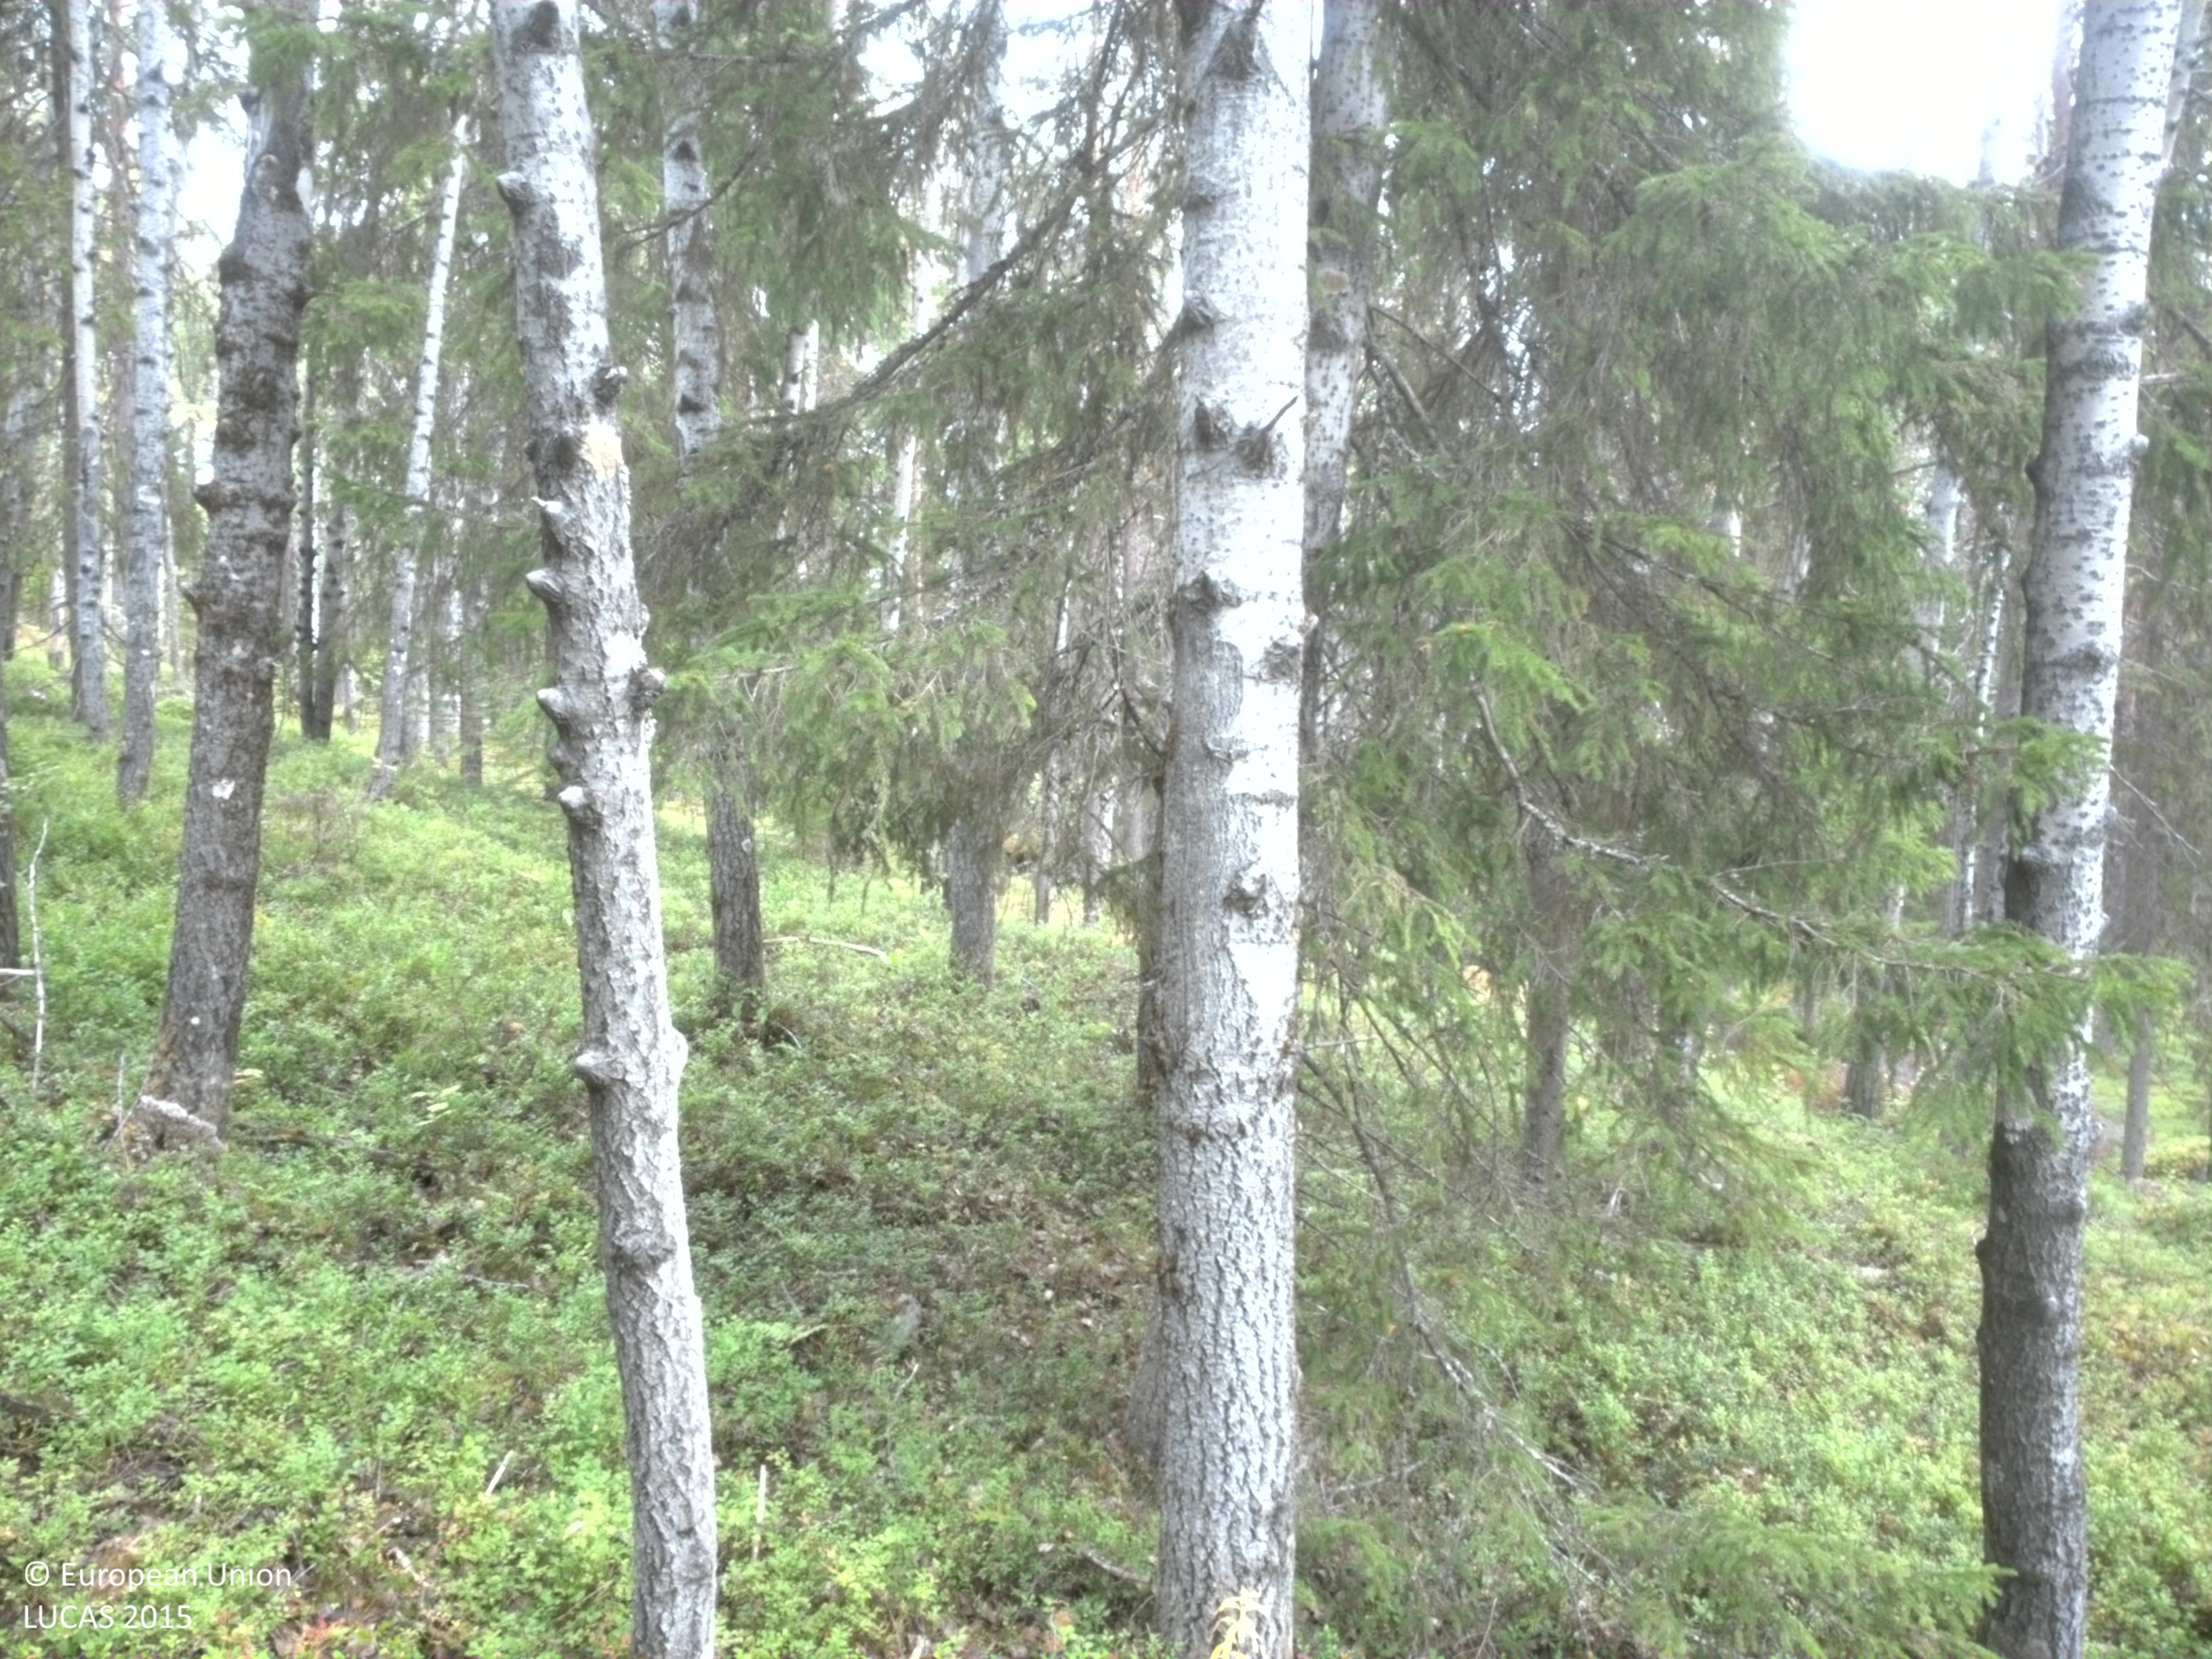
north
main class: Woodland
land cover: Spruce dominated mixed woodland
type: boreal forest
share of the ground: 50 - 75 %
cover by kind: coniferous forest trees 45 %, shrubs 30 %, broadleaved forest trees 15 %, lichens and mosses 10 %
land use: Forestry
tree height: > 5 m
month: September
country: SE
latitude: 64.6064
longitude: 19.7739
